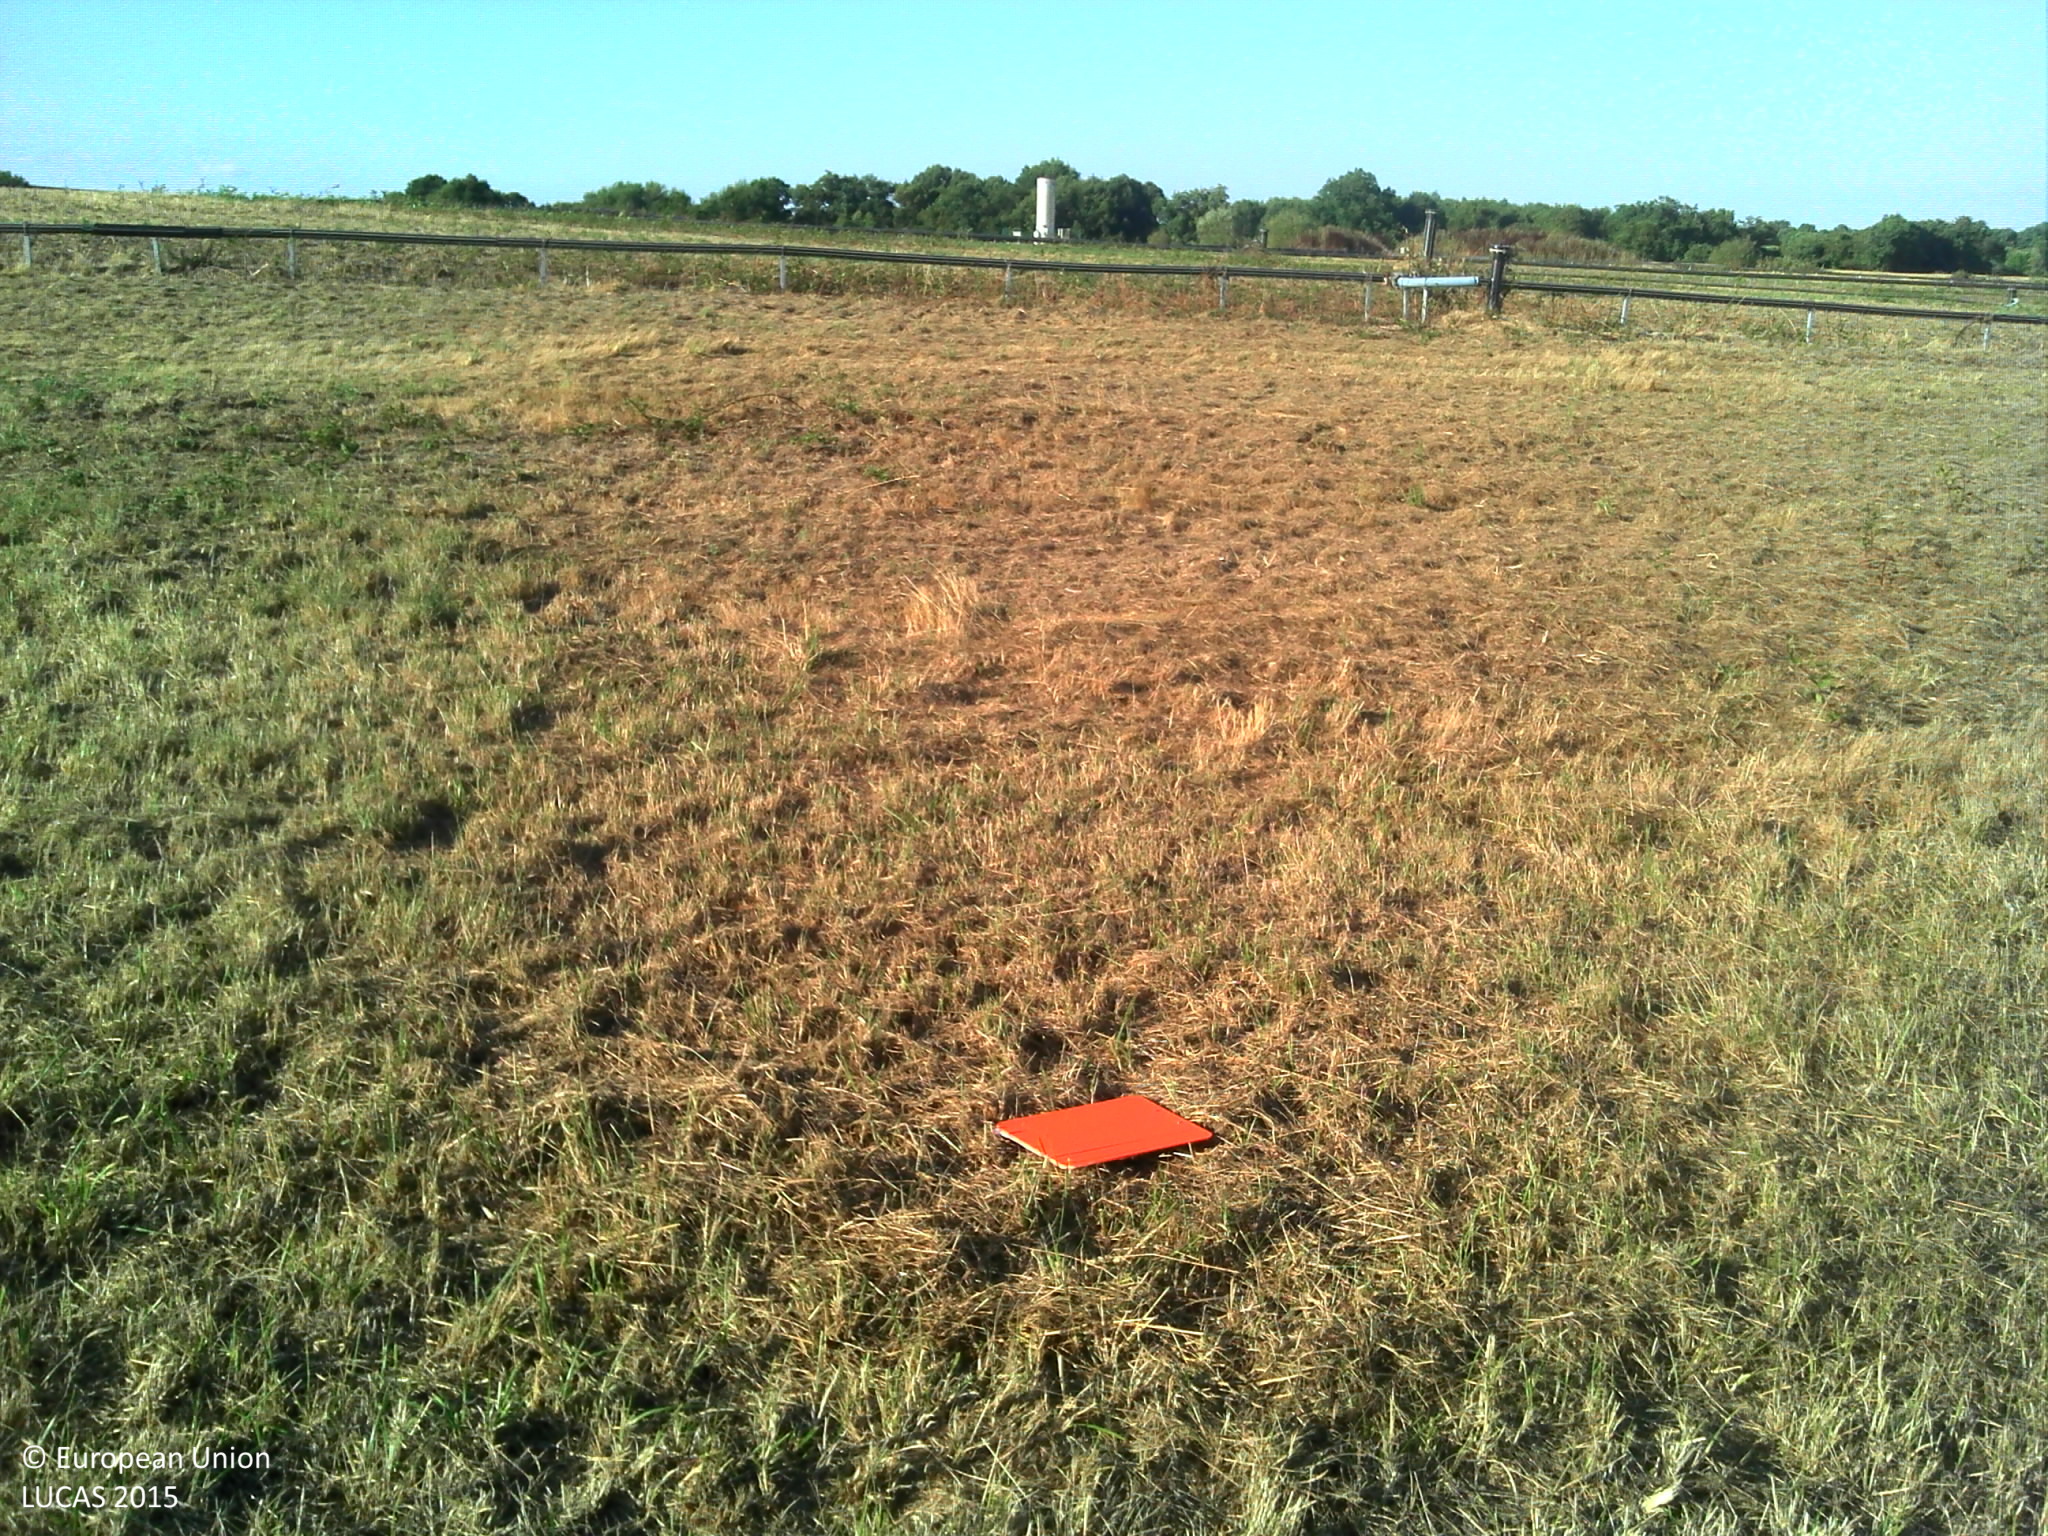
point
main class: Grassland
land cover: Grassland without tree/shrub cover
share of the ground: > 75 %
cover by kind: herbaceous plants 100 %
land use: Community services
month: August
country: FR
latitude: 46.6523
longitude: -1.3658
